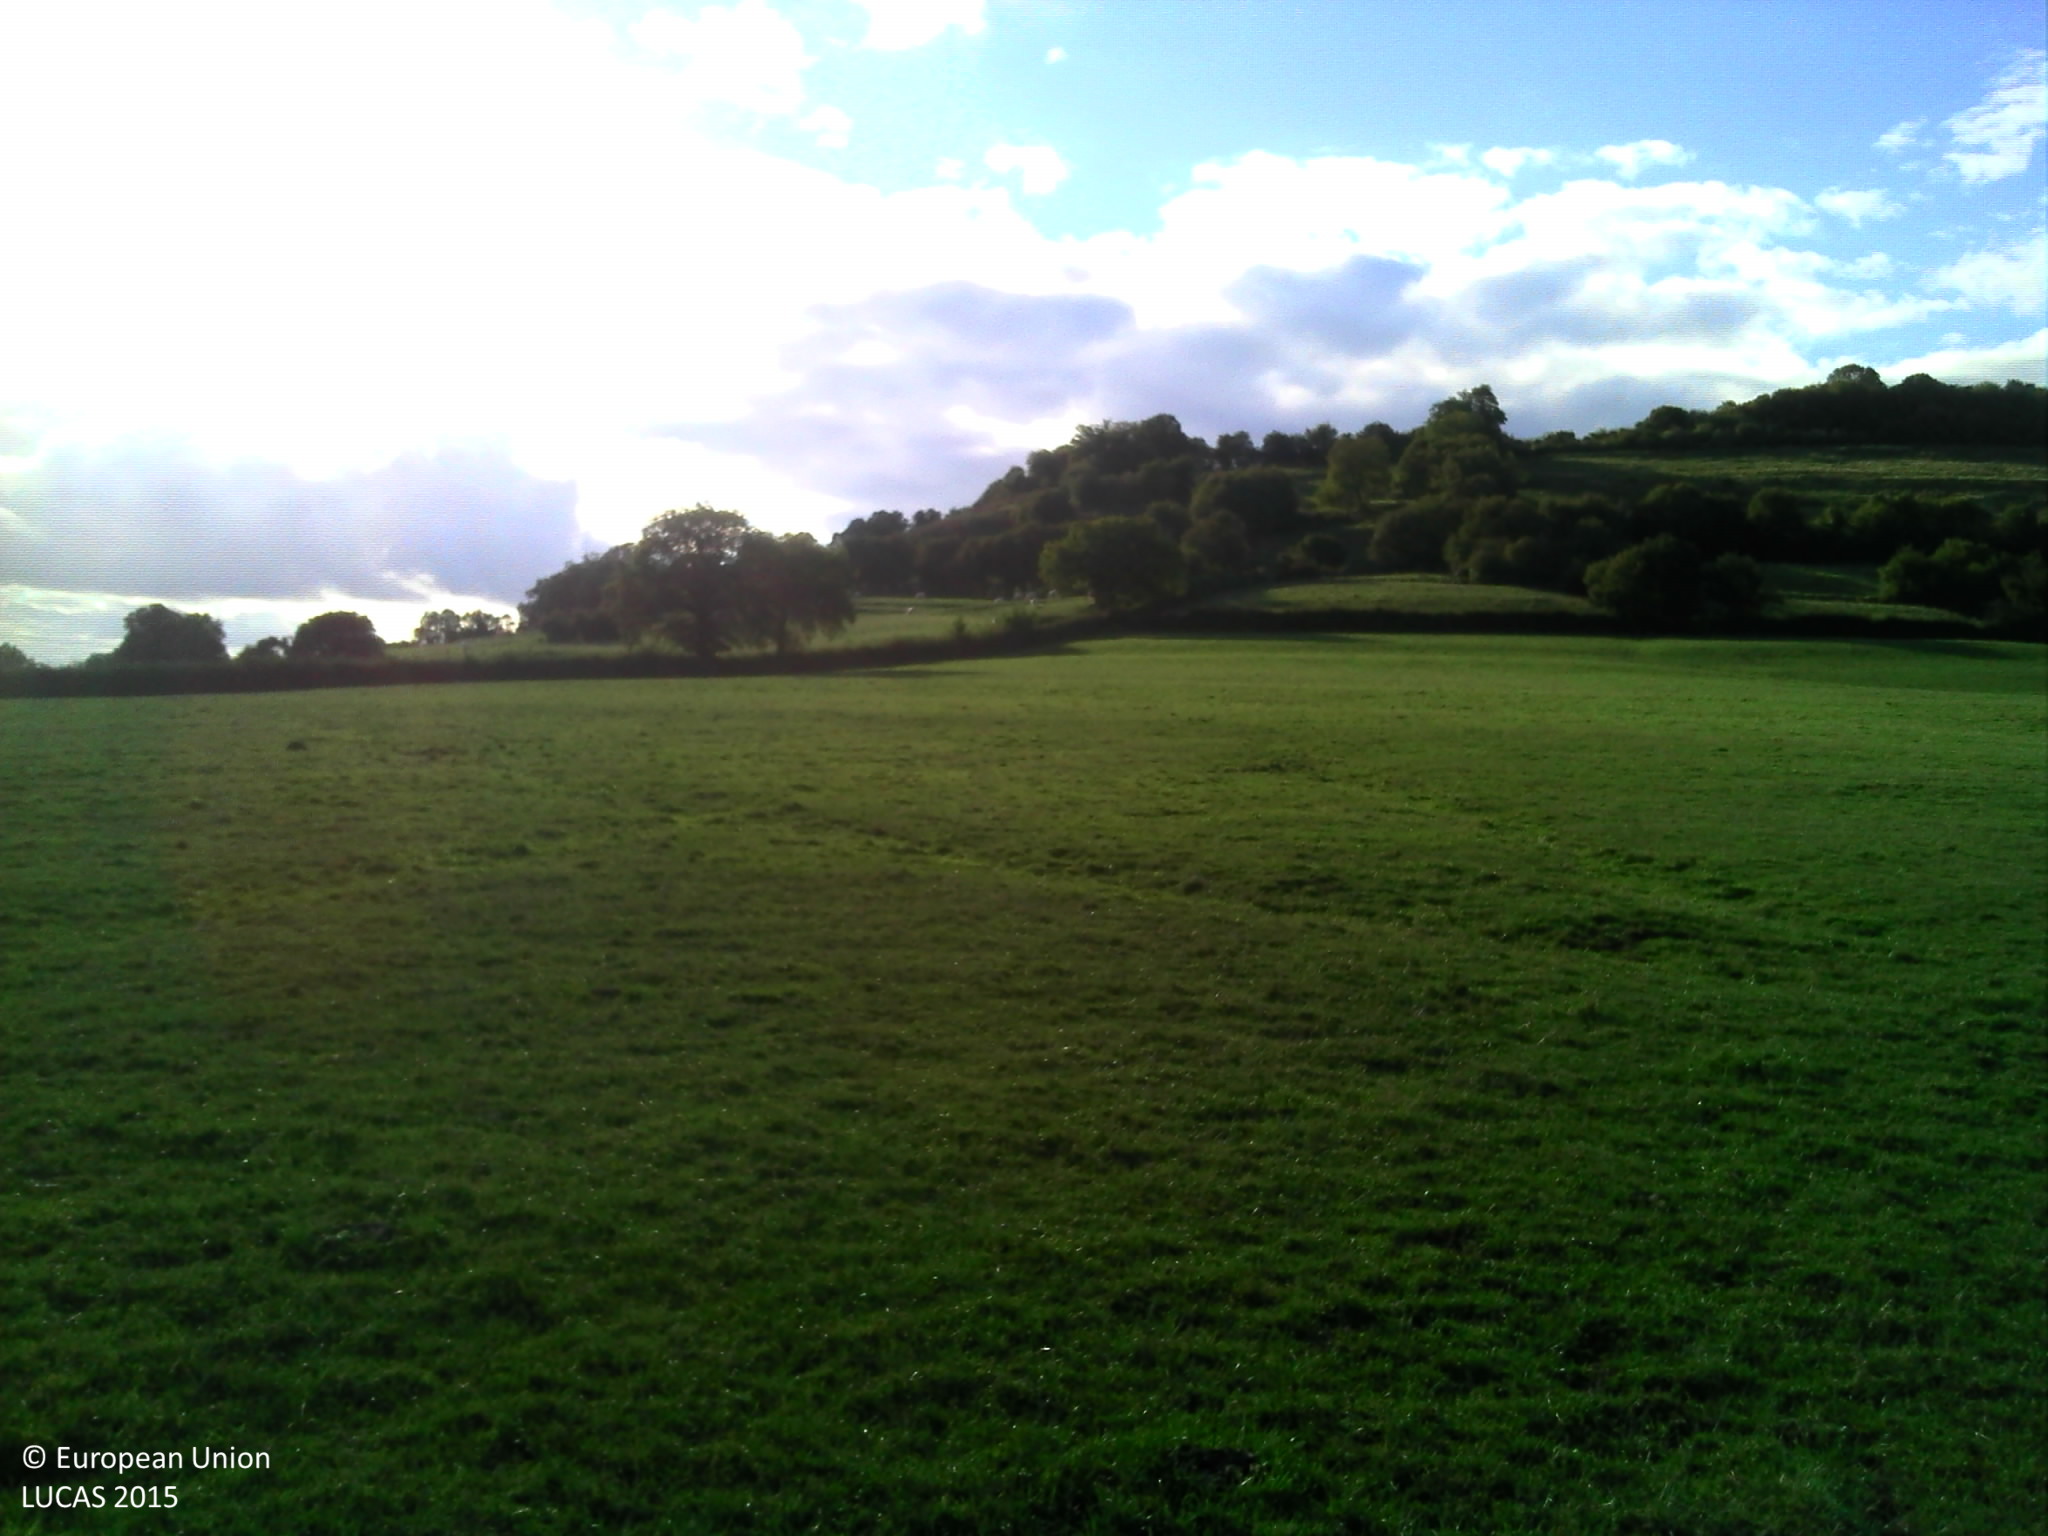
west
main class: Grassland
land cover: Grassland without tree/shrub cover
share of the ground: > 75 %
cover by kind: herbaceous plants 100 %
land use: Agriculture (excluding fallow land and kitchen gardens)
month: September
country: FR
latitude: 47.1401
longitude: 4.3429
